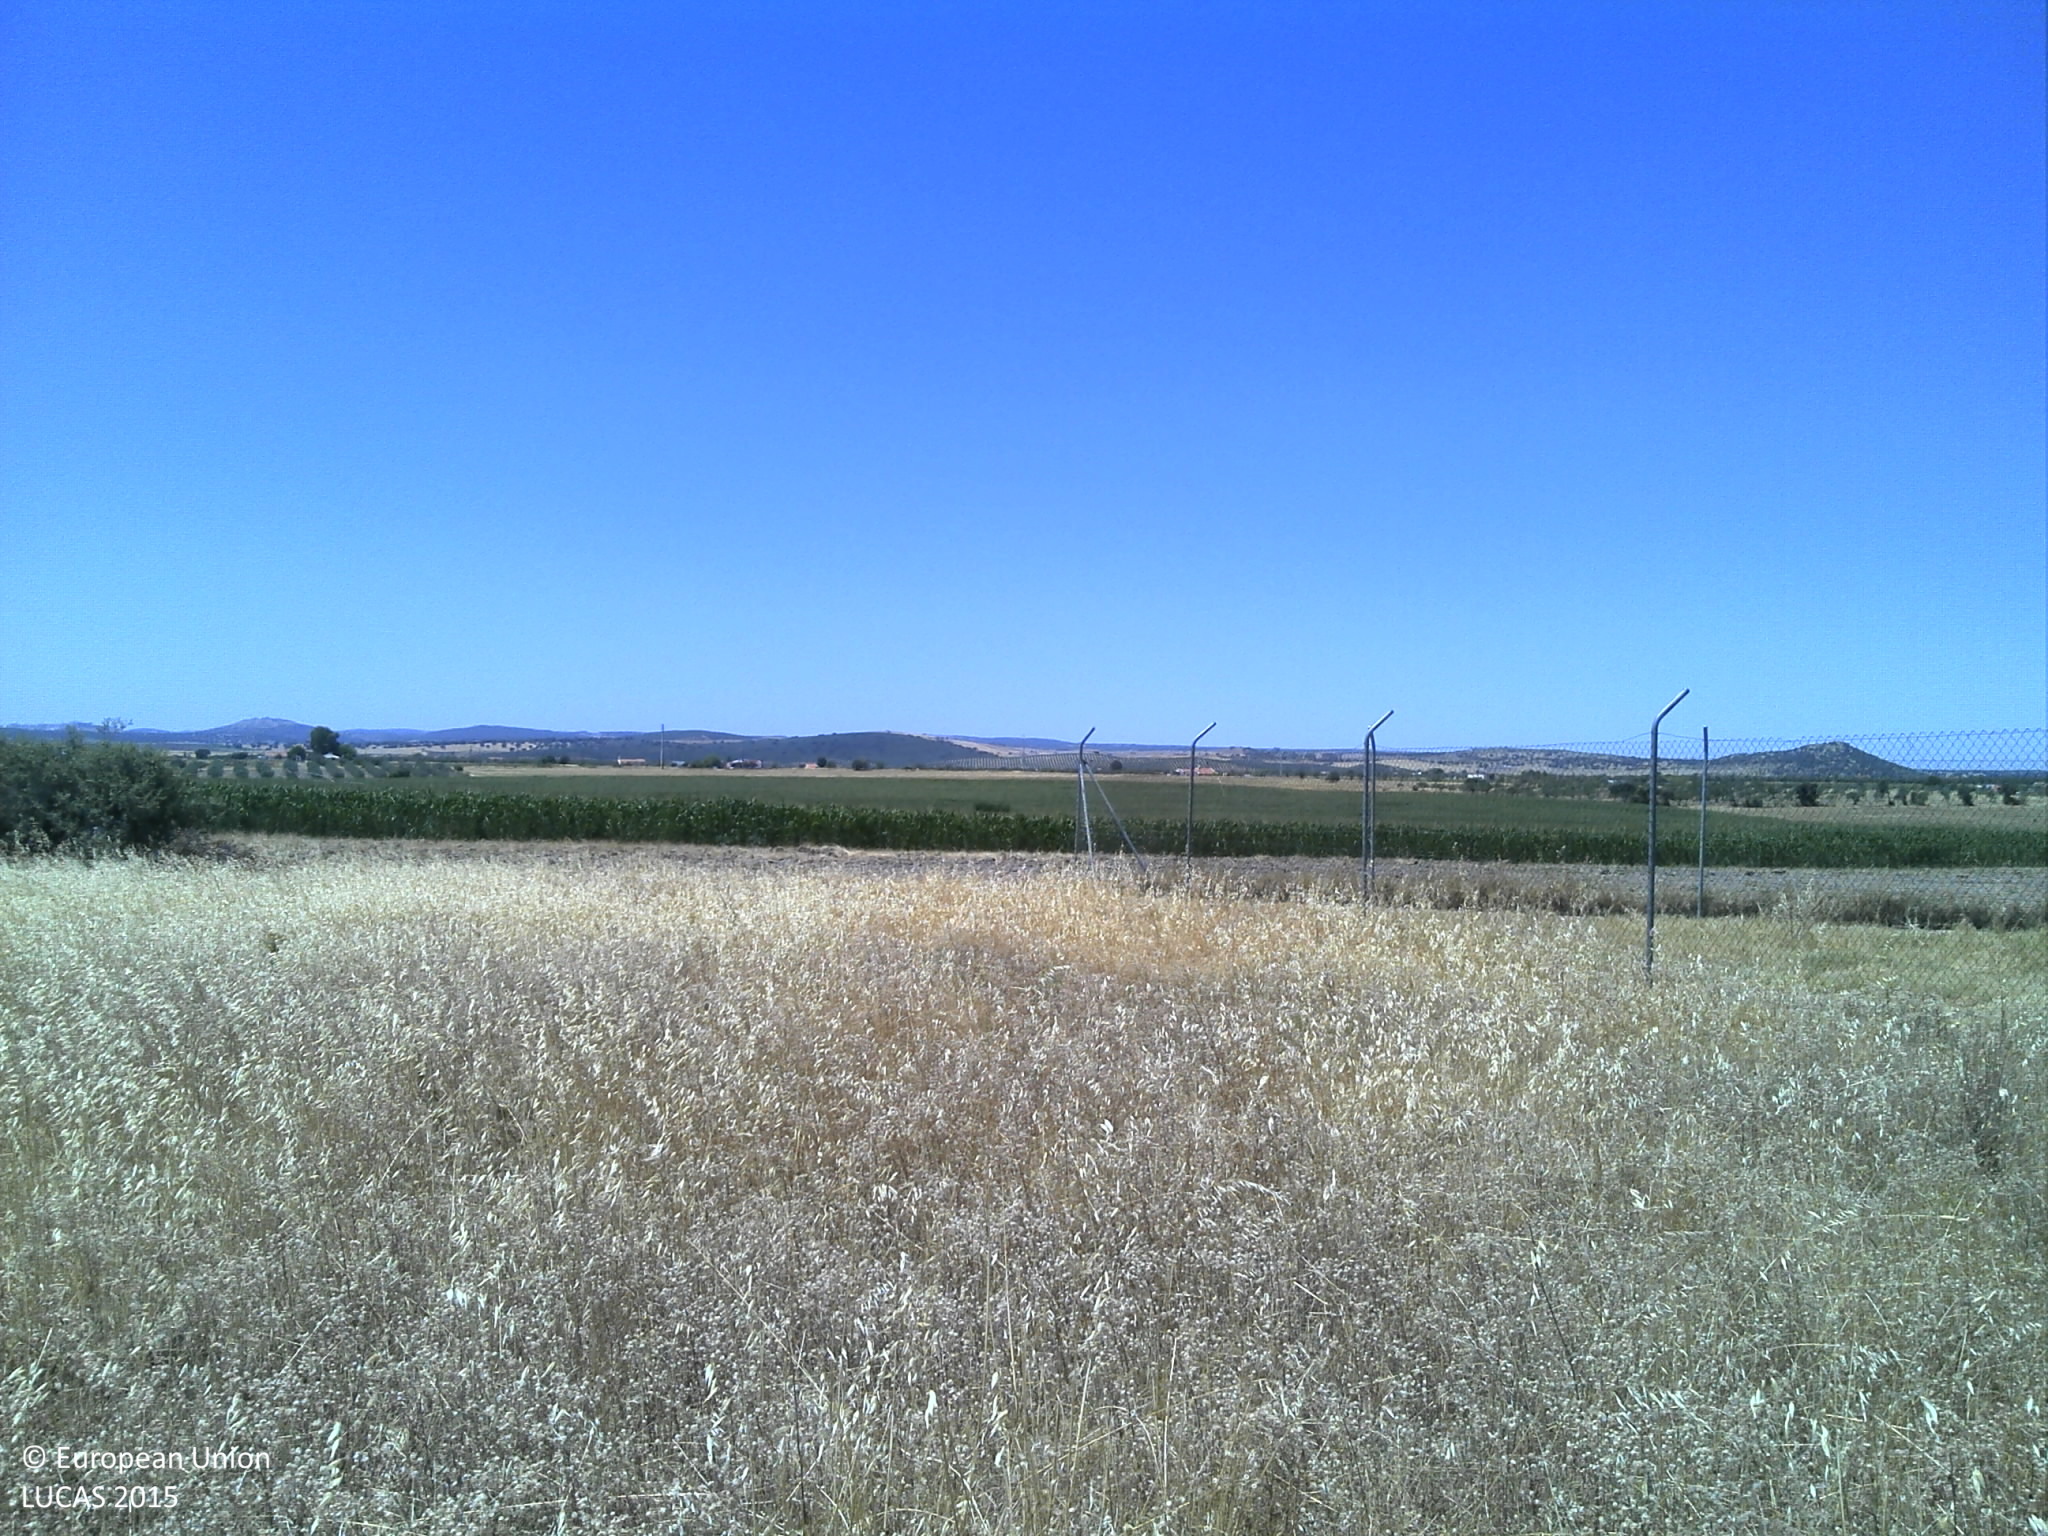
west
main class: Grassland
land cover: Spontaneously vegetated surfaces
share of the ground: 50 - 75 %
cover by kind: herbaceous plants 75 %, unconsolidated bare surface 25 %
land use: Fallow land
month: July
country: PT
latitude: 38.9653
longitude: -7.0501
